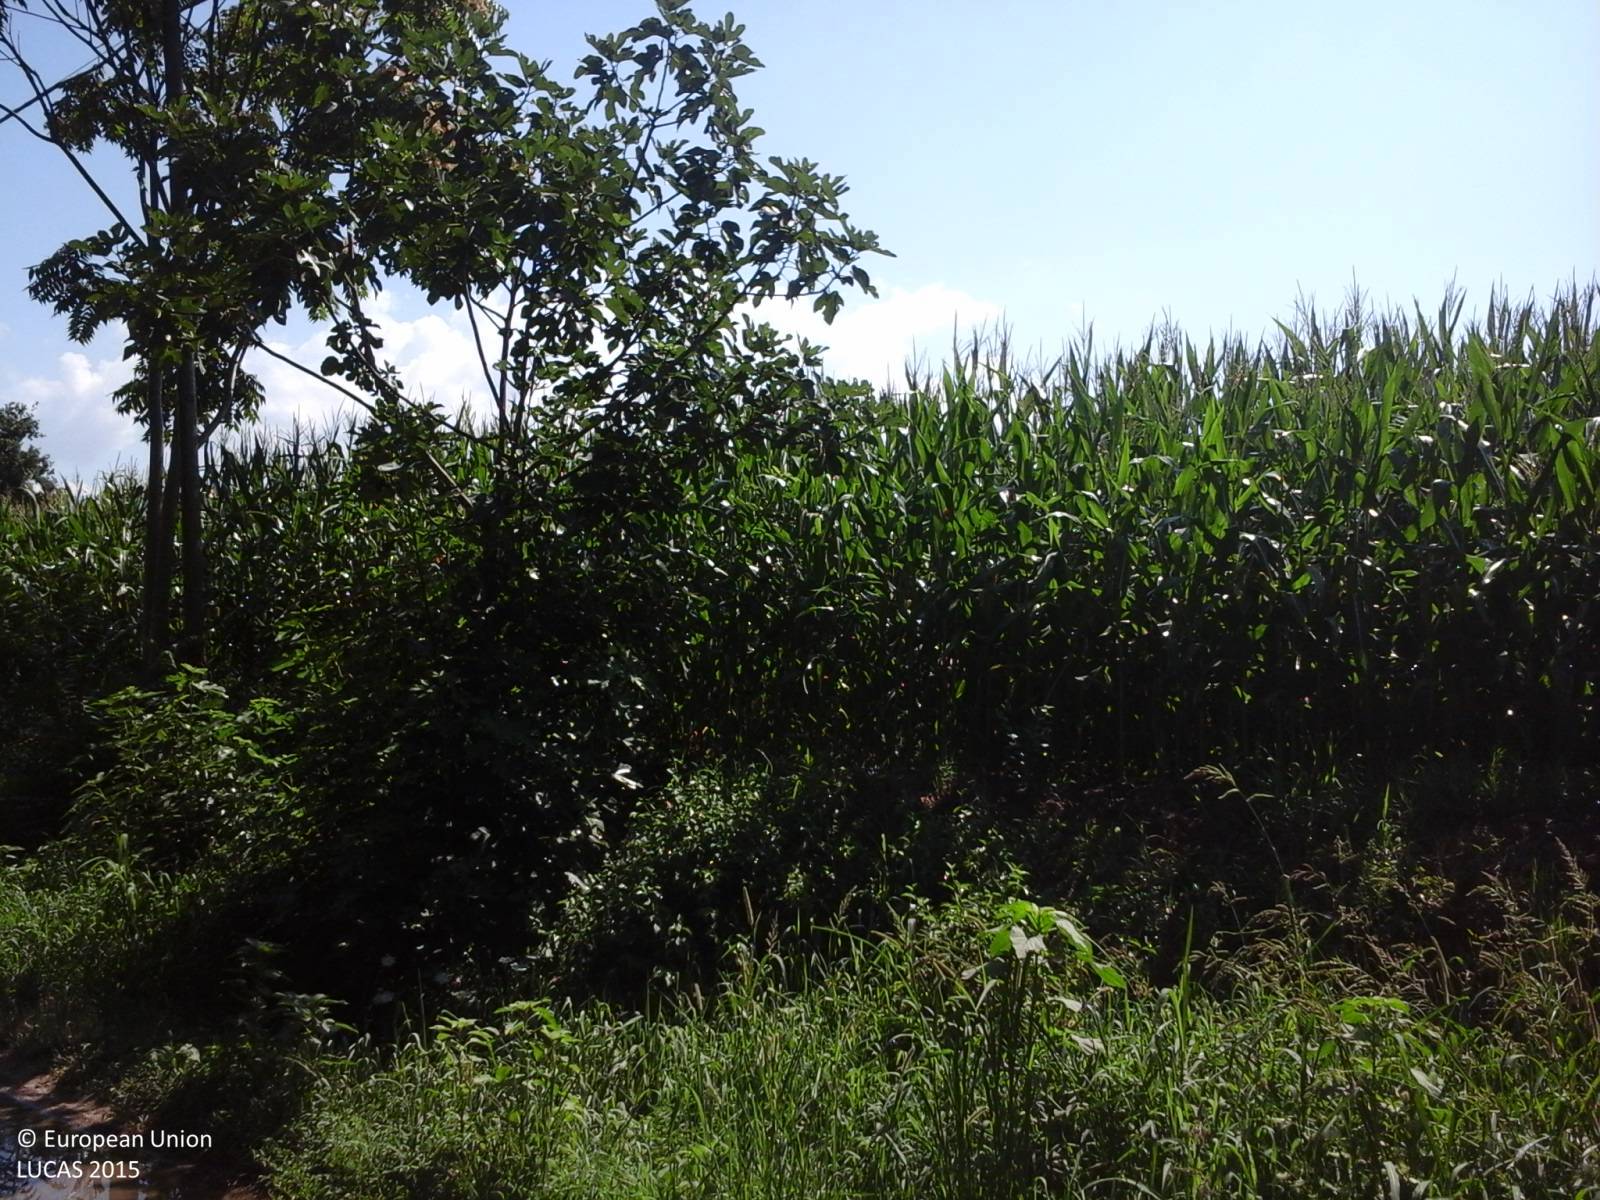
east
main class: Cropland
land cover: Maize
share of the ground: > 75 %
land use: Agriculture (excluding fallow land and kitchen gardens)
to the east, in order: Maize; Lucerne; Lines of trees; Tracks; Lines of trees; Temporary grasslands; Electric lines; Temporary grasslands; Abandoned hedges
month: August
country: IT
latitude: 41.3566
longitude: 14.1559
